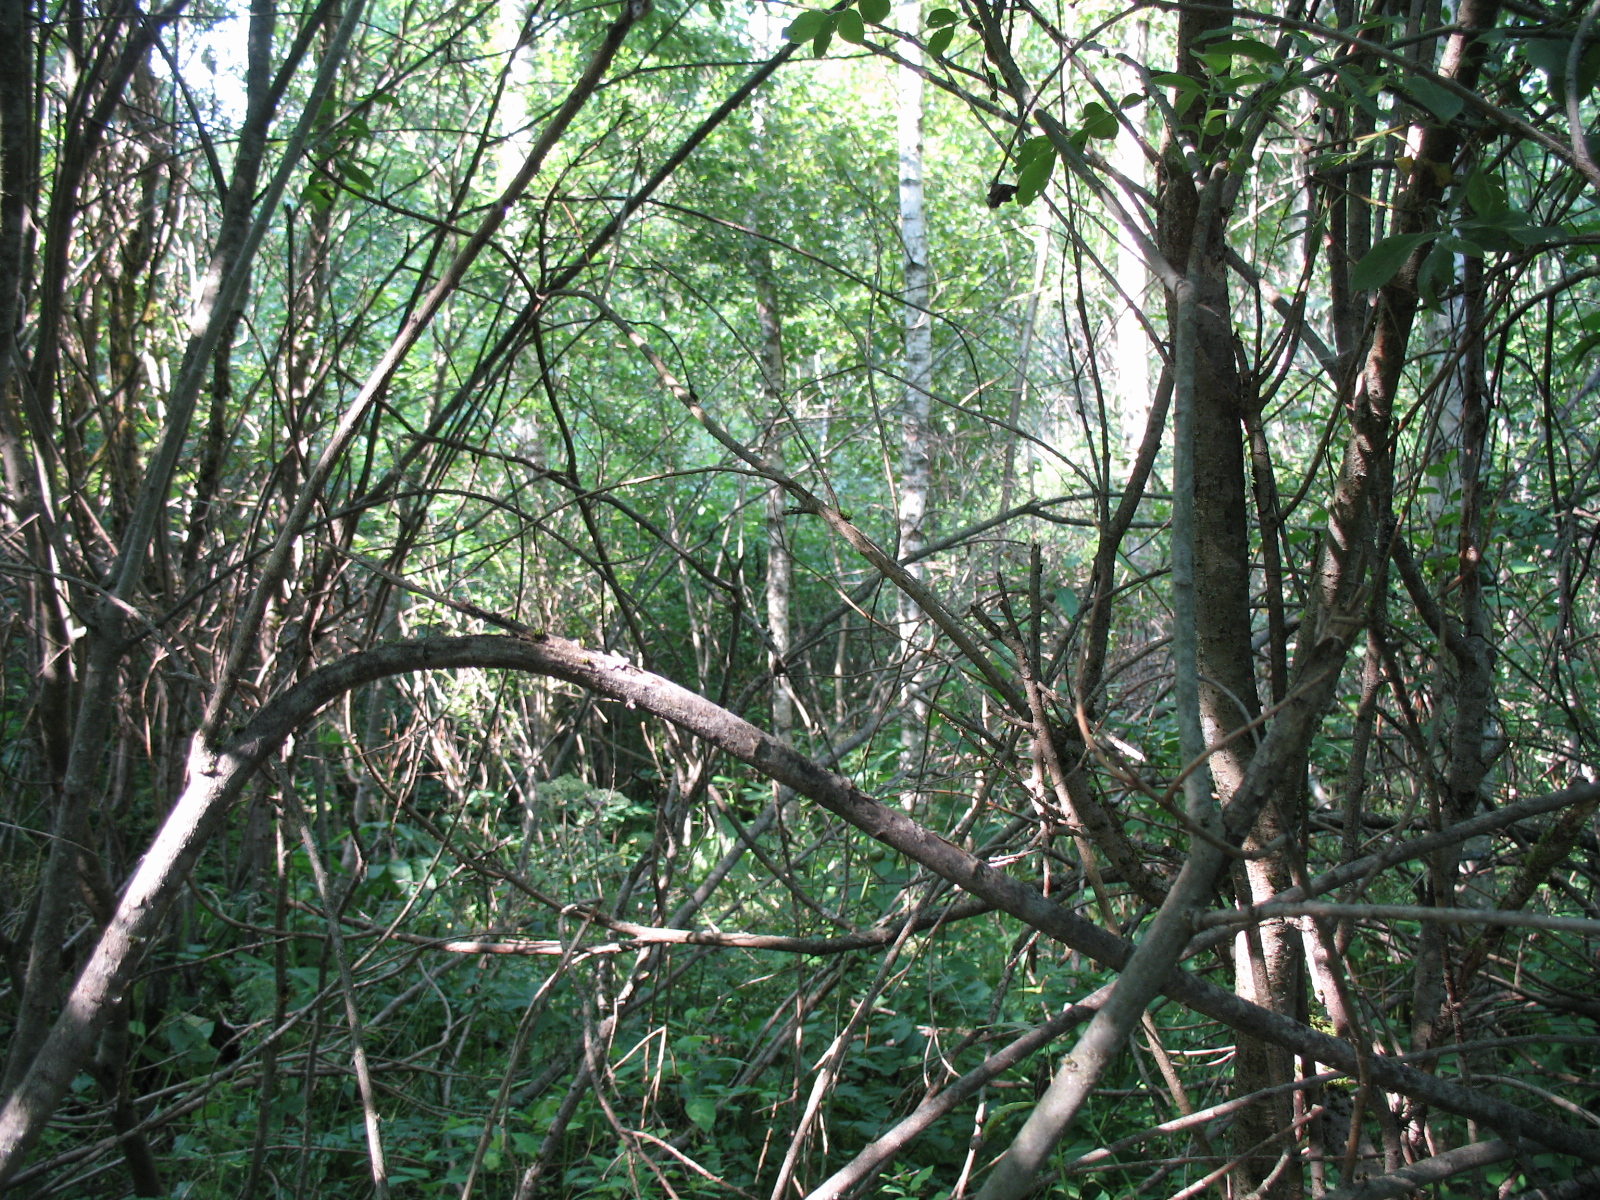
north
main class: Woodland
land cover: Broadleaved woodland
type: non-riverine alder, birch or aspen forest
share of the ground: > 75 %
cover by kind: broadleaved forest trees 85 %, shrubs 10 %, herbaceous plants 5 %
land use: Forestry
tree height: > 5 m
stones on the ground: < 10 %
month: August
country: LV
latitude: 56.4779
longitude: 25.5622
